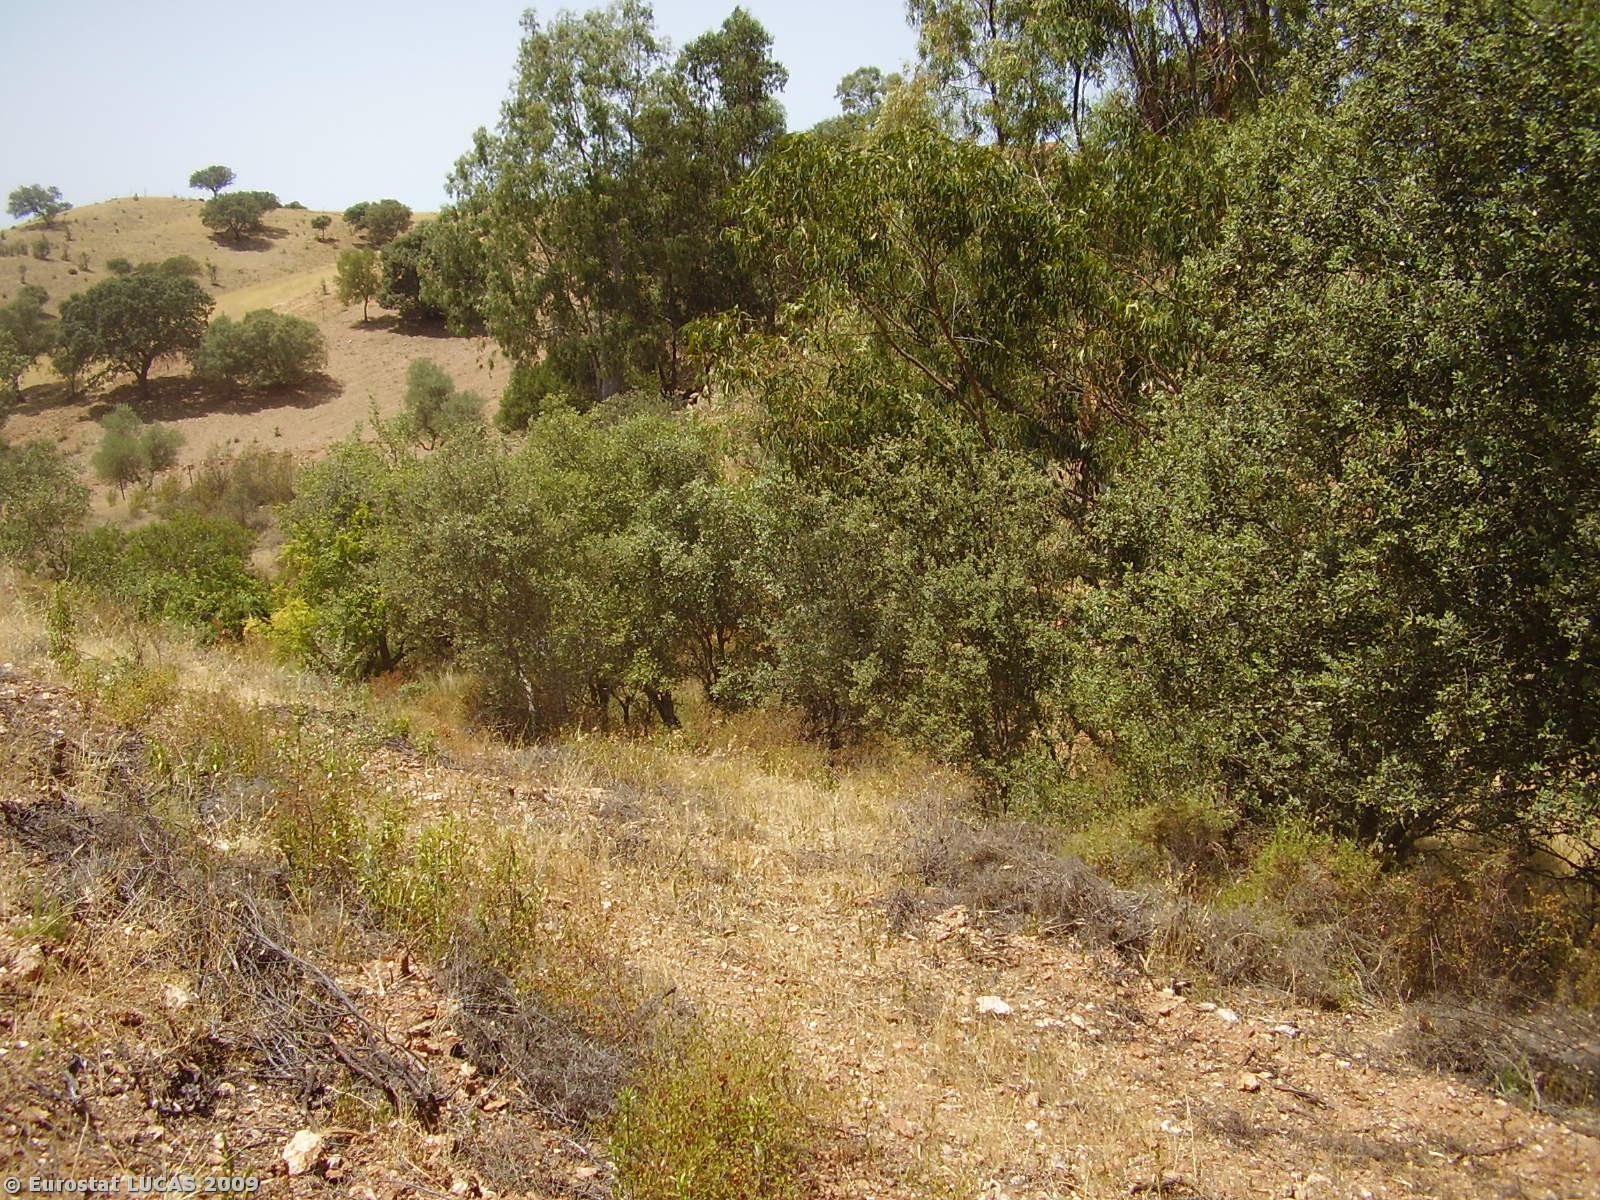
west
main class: Woodland
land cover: Broadleaved woodland
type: broadleaved evergreen forest
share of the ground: 10 - 25 %
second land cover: Grassland with sparse tree/shrub cover
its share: > 75 %
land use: Forestry
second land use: Fallow land
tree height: > 5 m
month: July
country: PT
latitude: 37.7528
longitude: -7.6207
